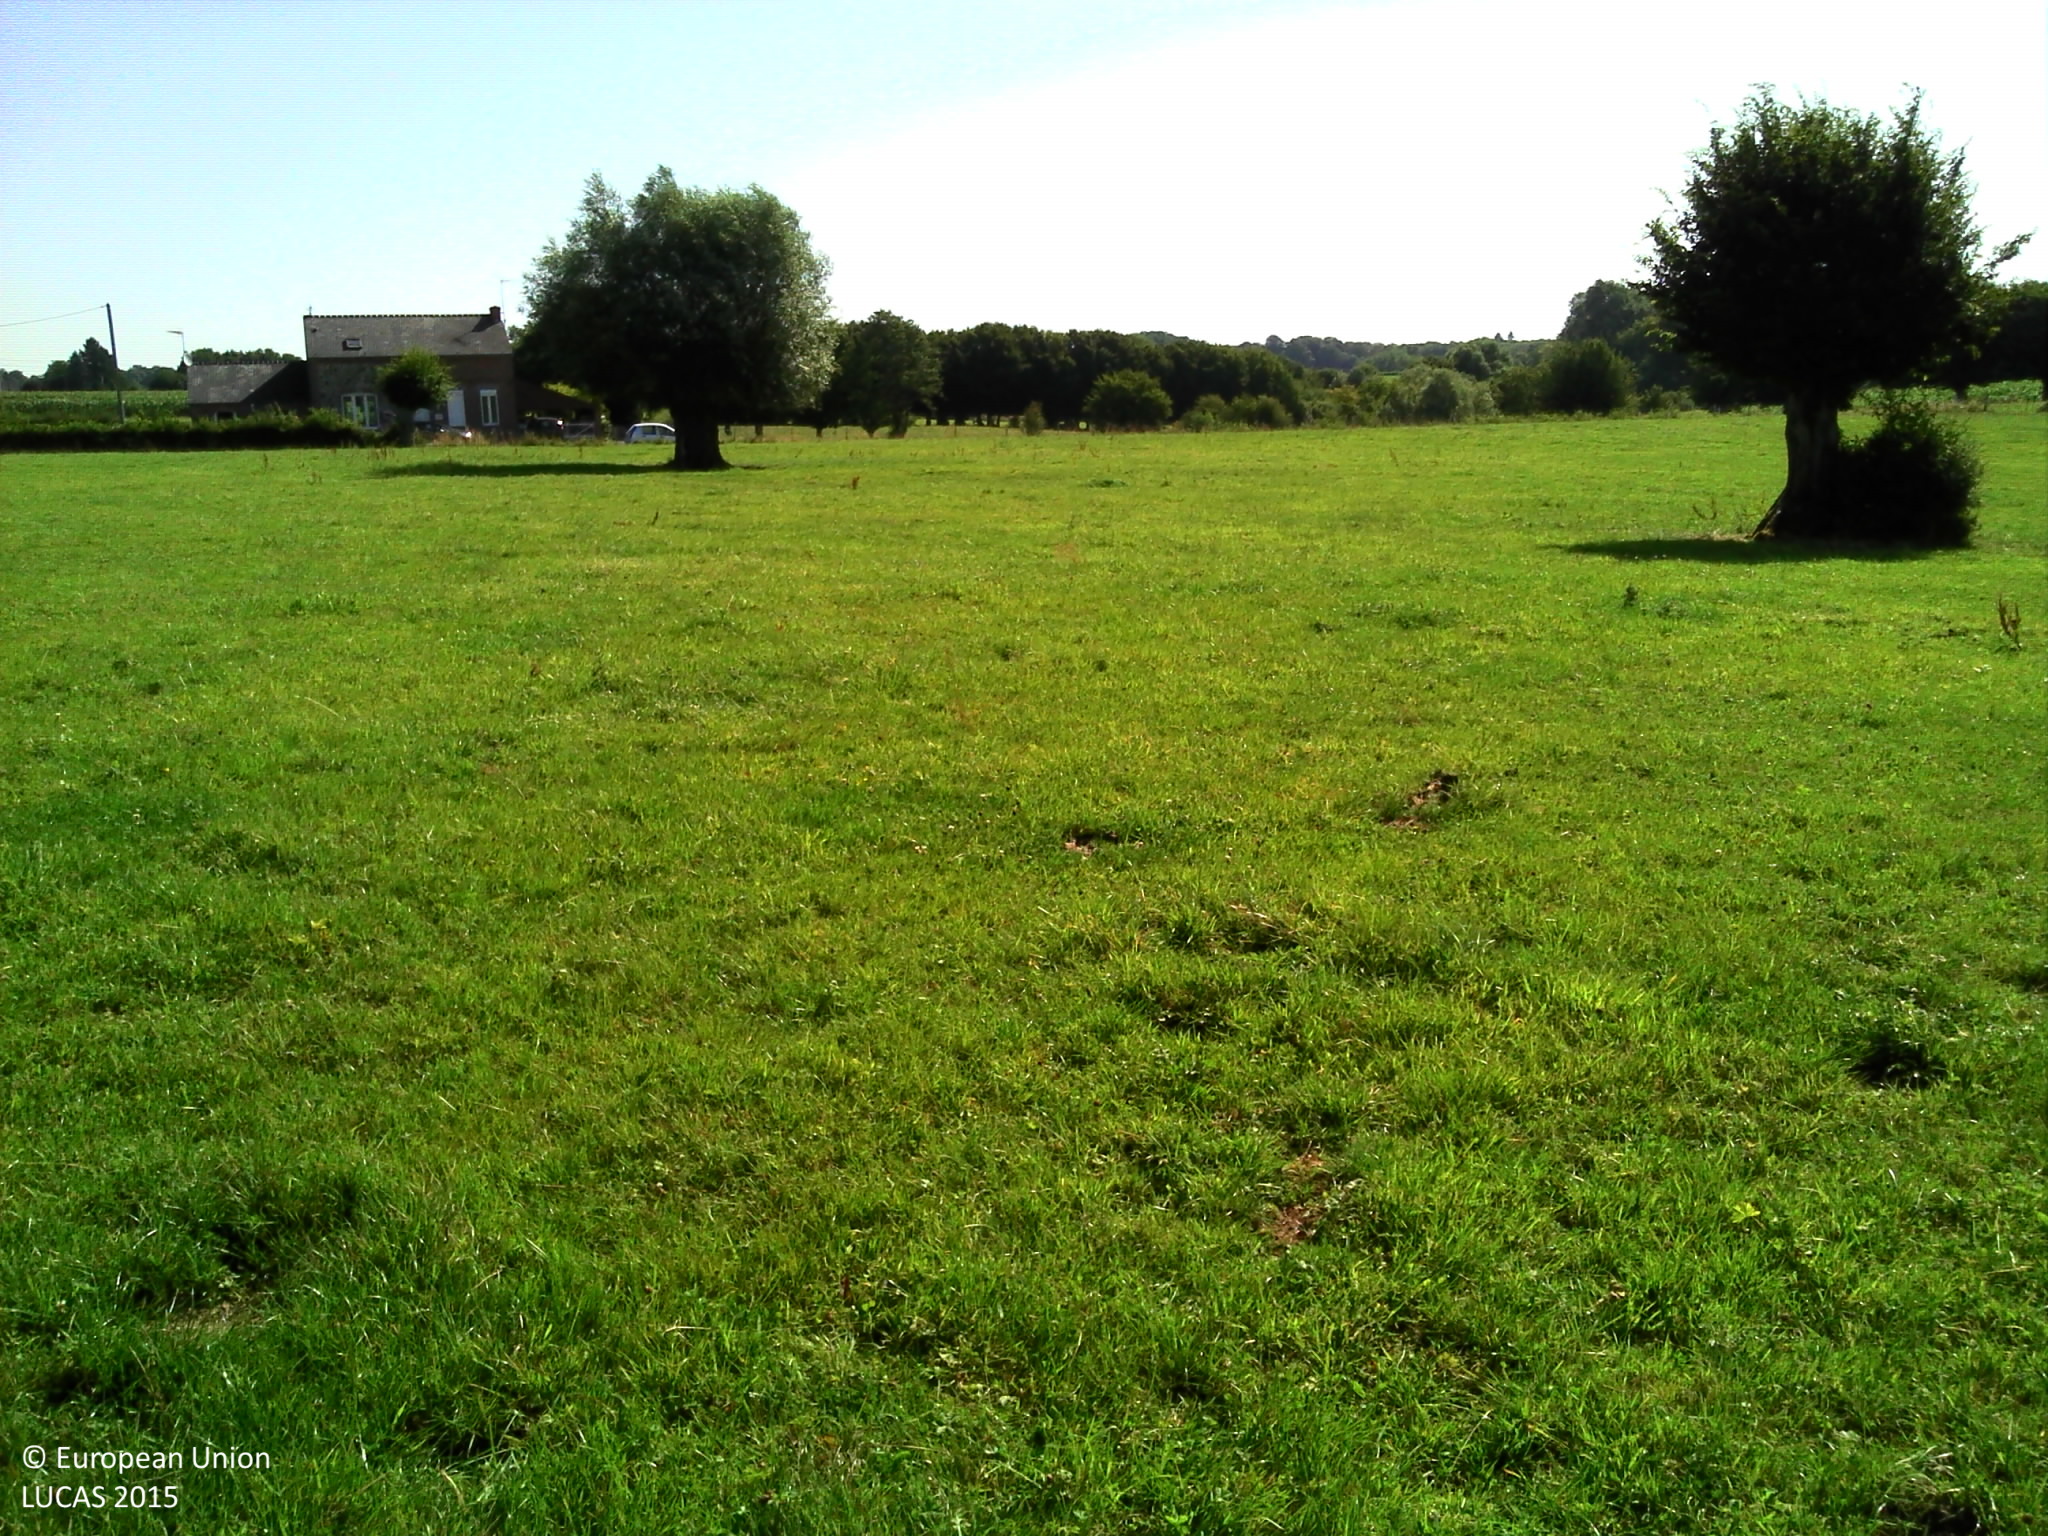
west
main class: Grassland
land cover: Grassland without tree/shrub cover
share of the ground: > 75 %
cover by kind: herbaceous plants 95 %, lichens and mosses 5 %
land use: Agriculture (excluding fallow land and kitchen gardens)
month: August
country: FR
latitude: 50.0818
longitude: 4.0272
